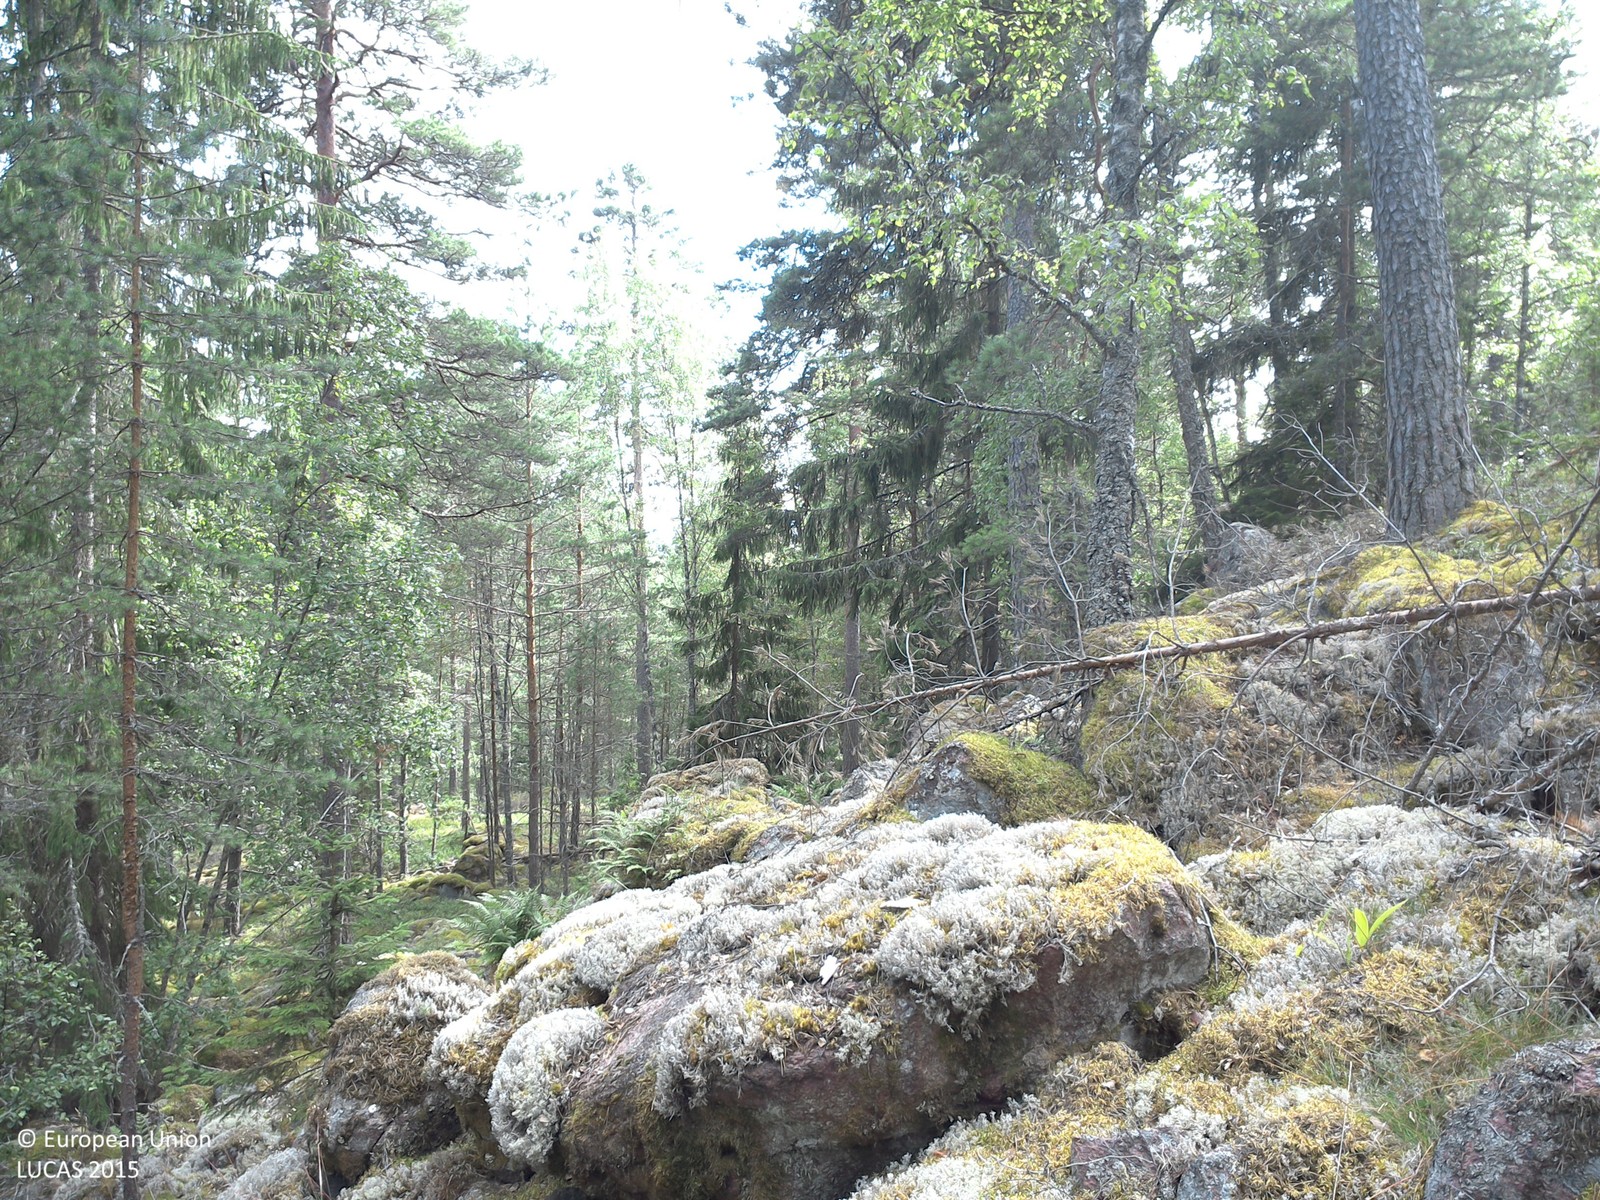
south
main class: Woodland
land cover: Pine dominated coniferous woodland
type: boreal forest
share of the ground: 25 - 50 %
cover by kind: lichens and mosses 50 %, coniferous forest trees 40 %, herbaceous plants 10 %
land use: Forestry
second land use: Amenities, museums, leisure
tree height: > 5 m
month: August
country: SE
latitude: 58.1456
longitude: 14.9721
